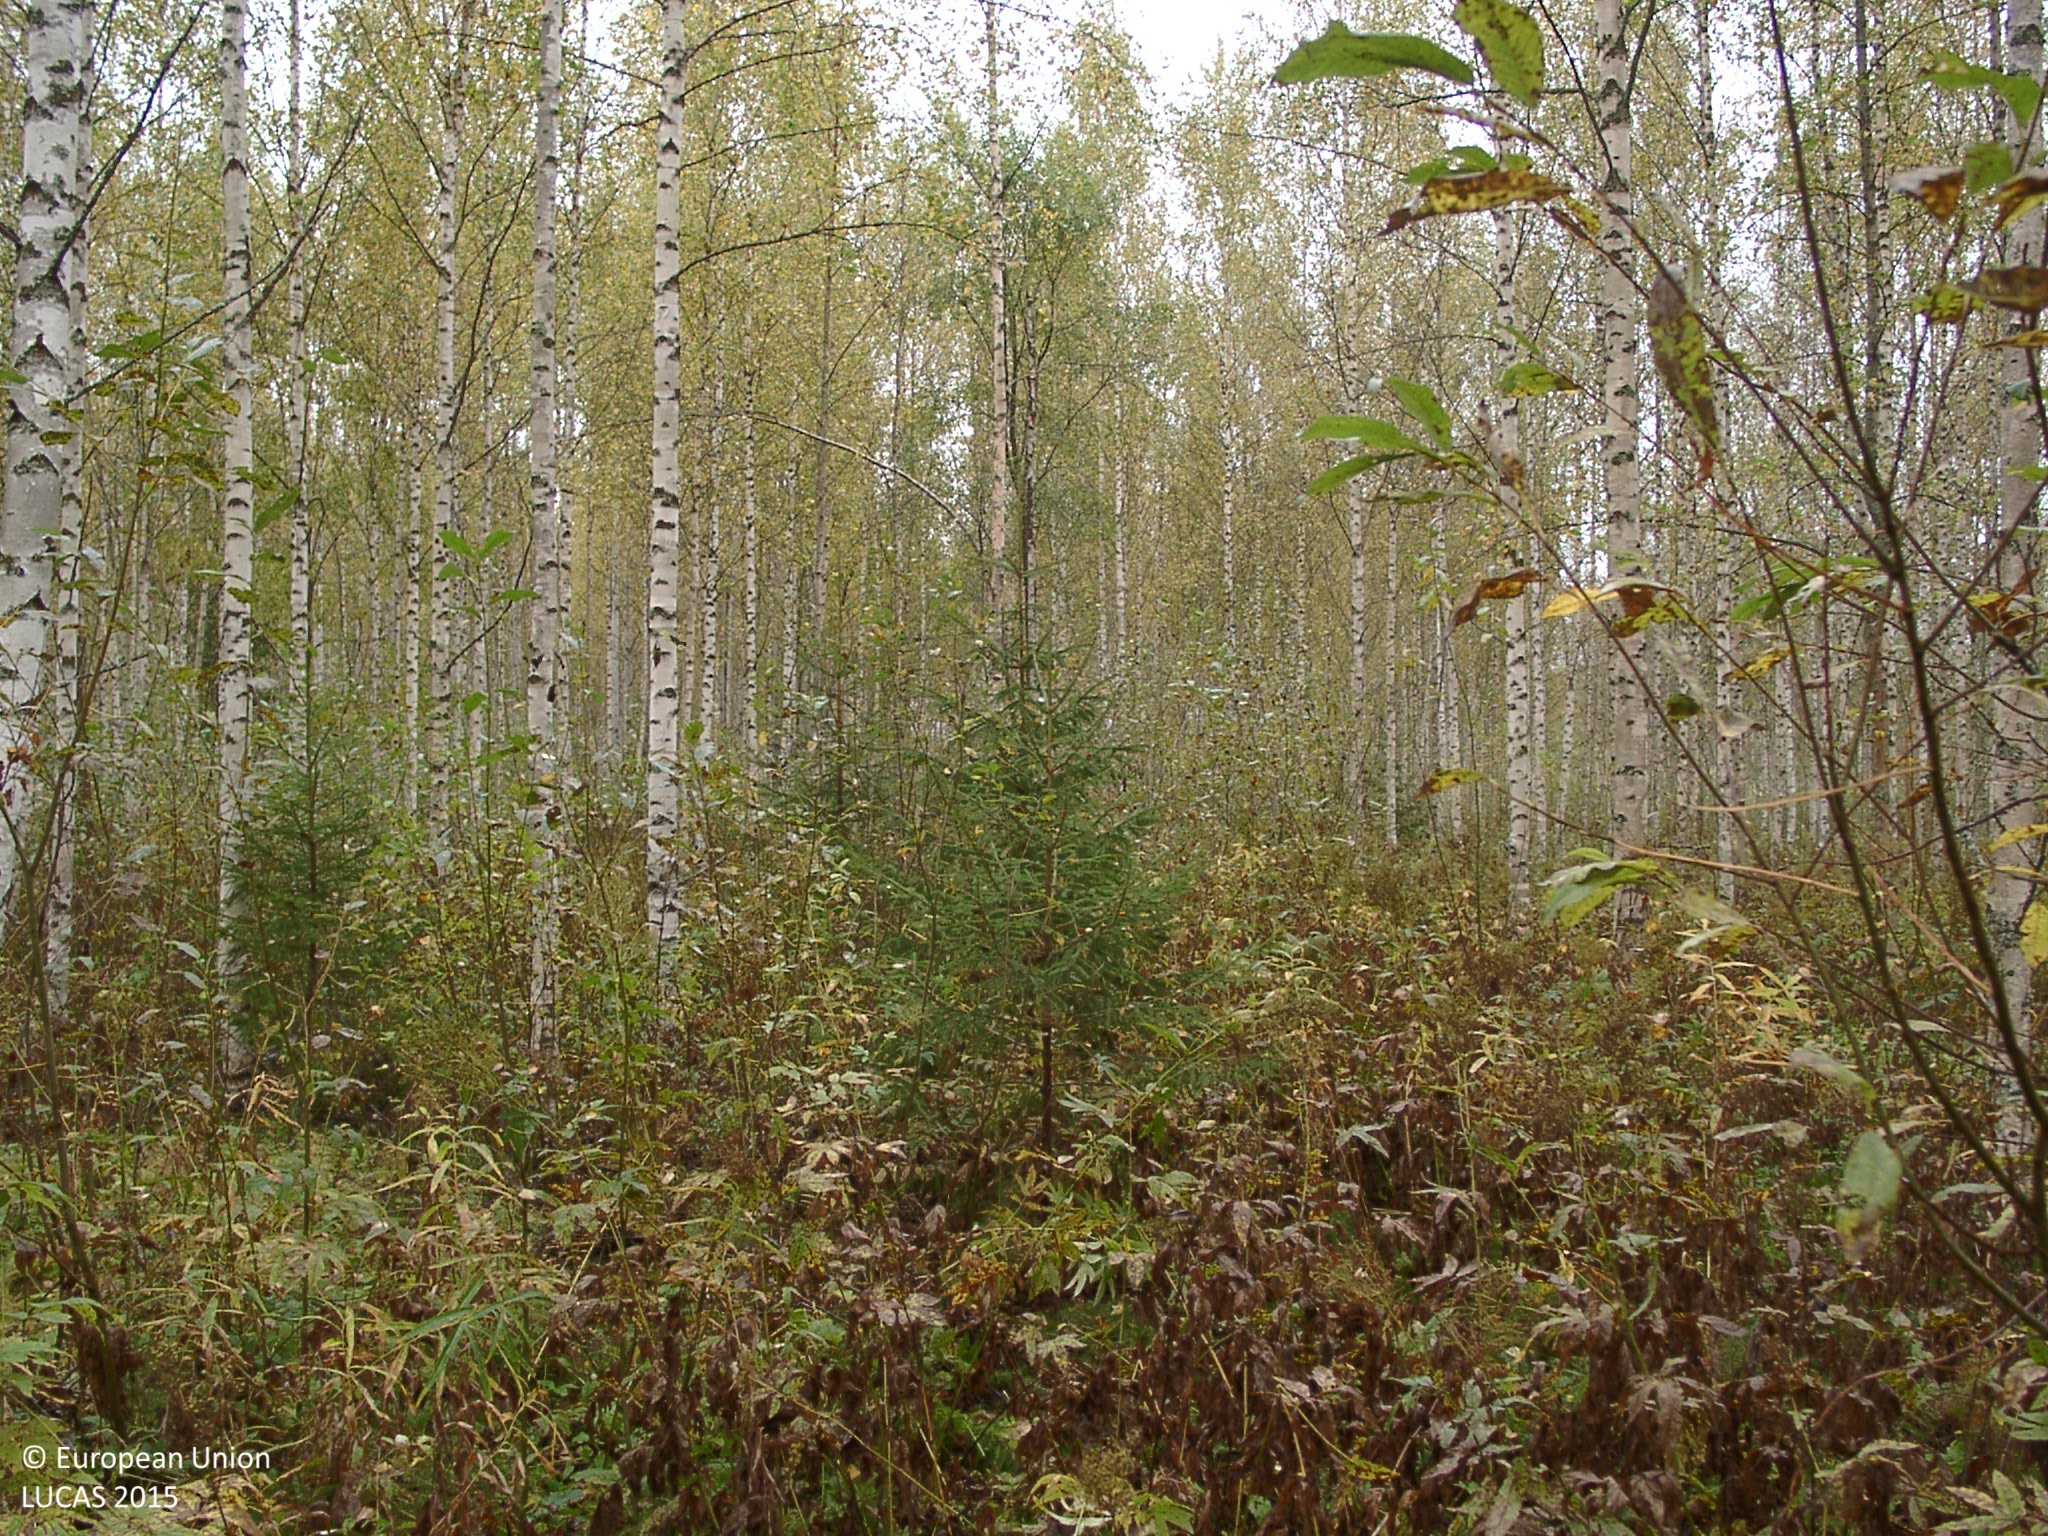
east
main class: Woodland
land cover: Broadleaved woodland
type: non-riverine alder, birch or aspen forest
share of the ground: 50 - 75 %
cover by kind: broadleaved forest trees 65 %, herbaceous plants 30 %, shrubs 5 %
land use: Forestry
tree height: > 5 m
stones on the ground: < 10 %
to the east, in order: Broadleaved woodland; Ditches and canals; Broadleaved woodland; Ditches and canals; Shrubland without tree cover; Rivers and streams; Shruby margins; Temporary grasslands; Ditches and canals; Pine dominated mixed woodland
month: September
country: FI
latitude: 62.7577
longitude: 25.3600
